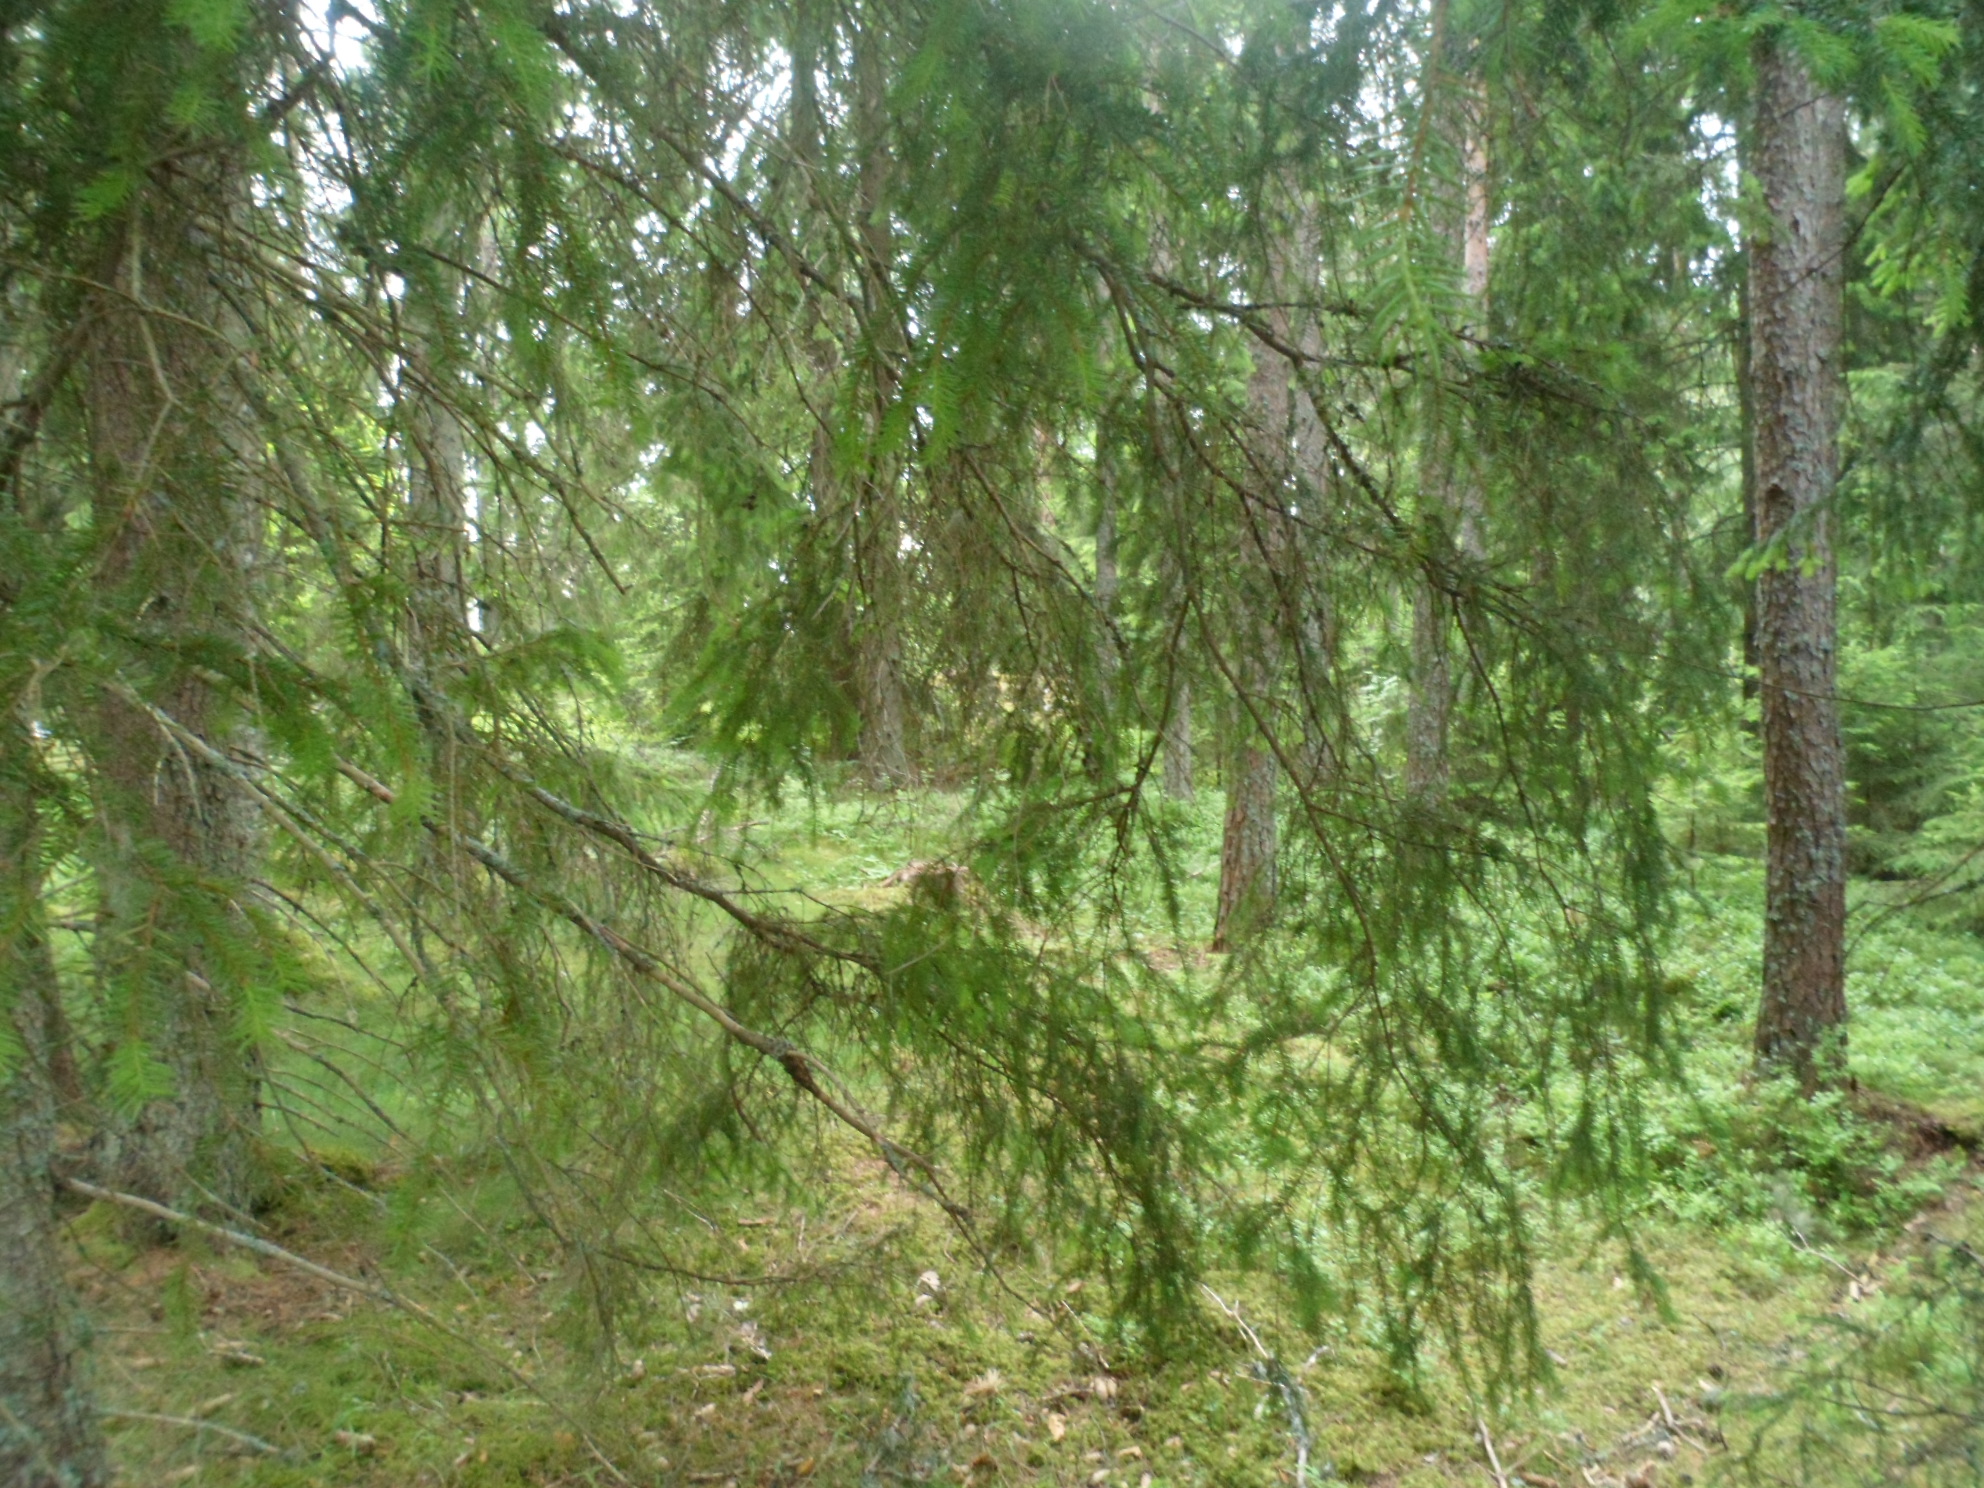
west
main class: Woodland
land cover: Spruce dominated coniferous woodland
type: boreal forest
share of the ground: 50 - 75 %
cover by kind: coniferous forest trees 60 %, shrubs 15 %, herbaceous plants 15 %, lichens and mosses 10 %
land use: Forestry
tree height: > 5 m
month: June
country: SE
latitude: 57.0231
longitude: 15.5494
